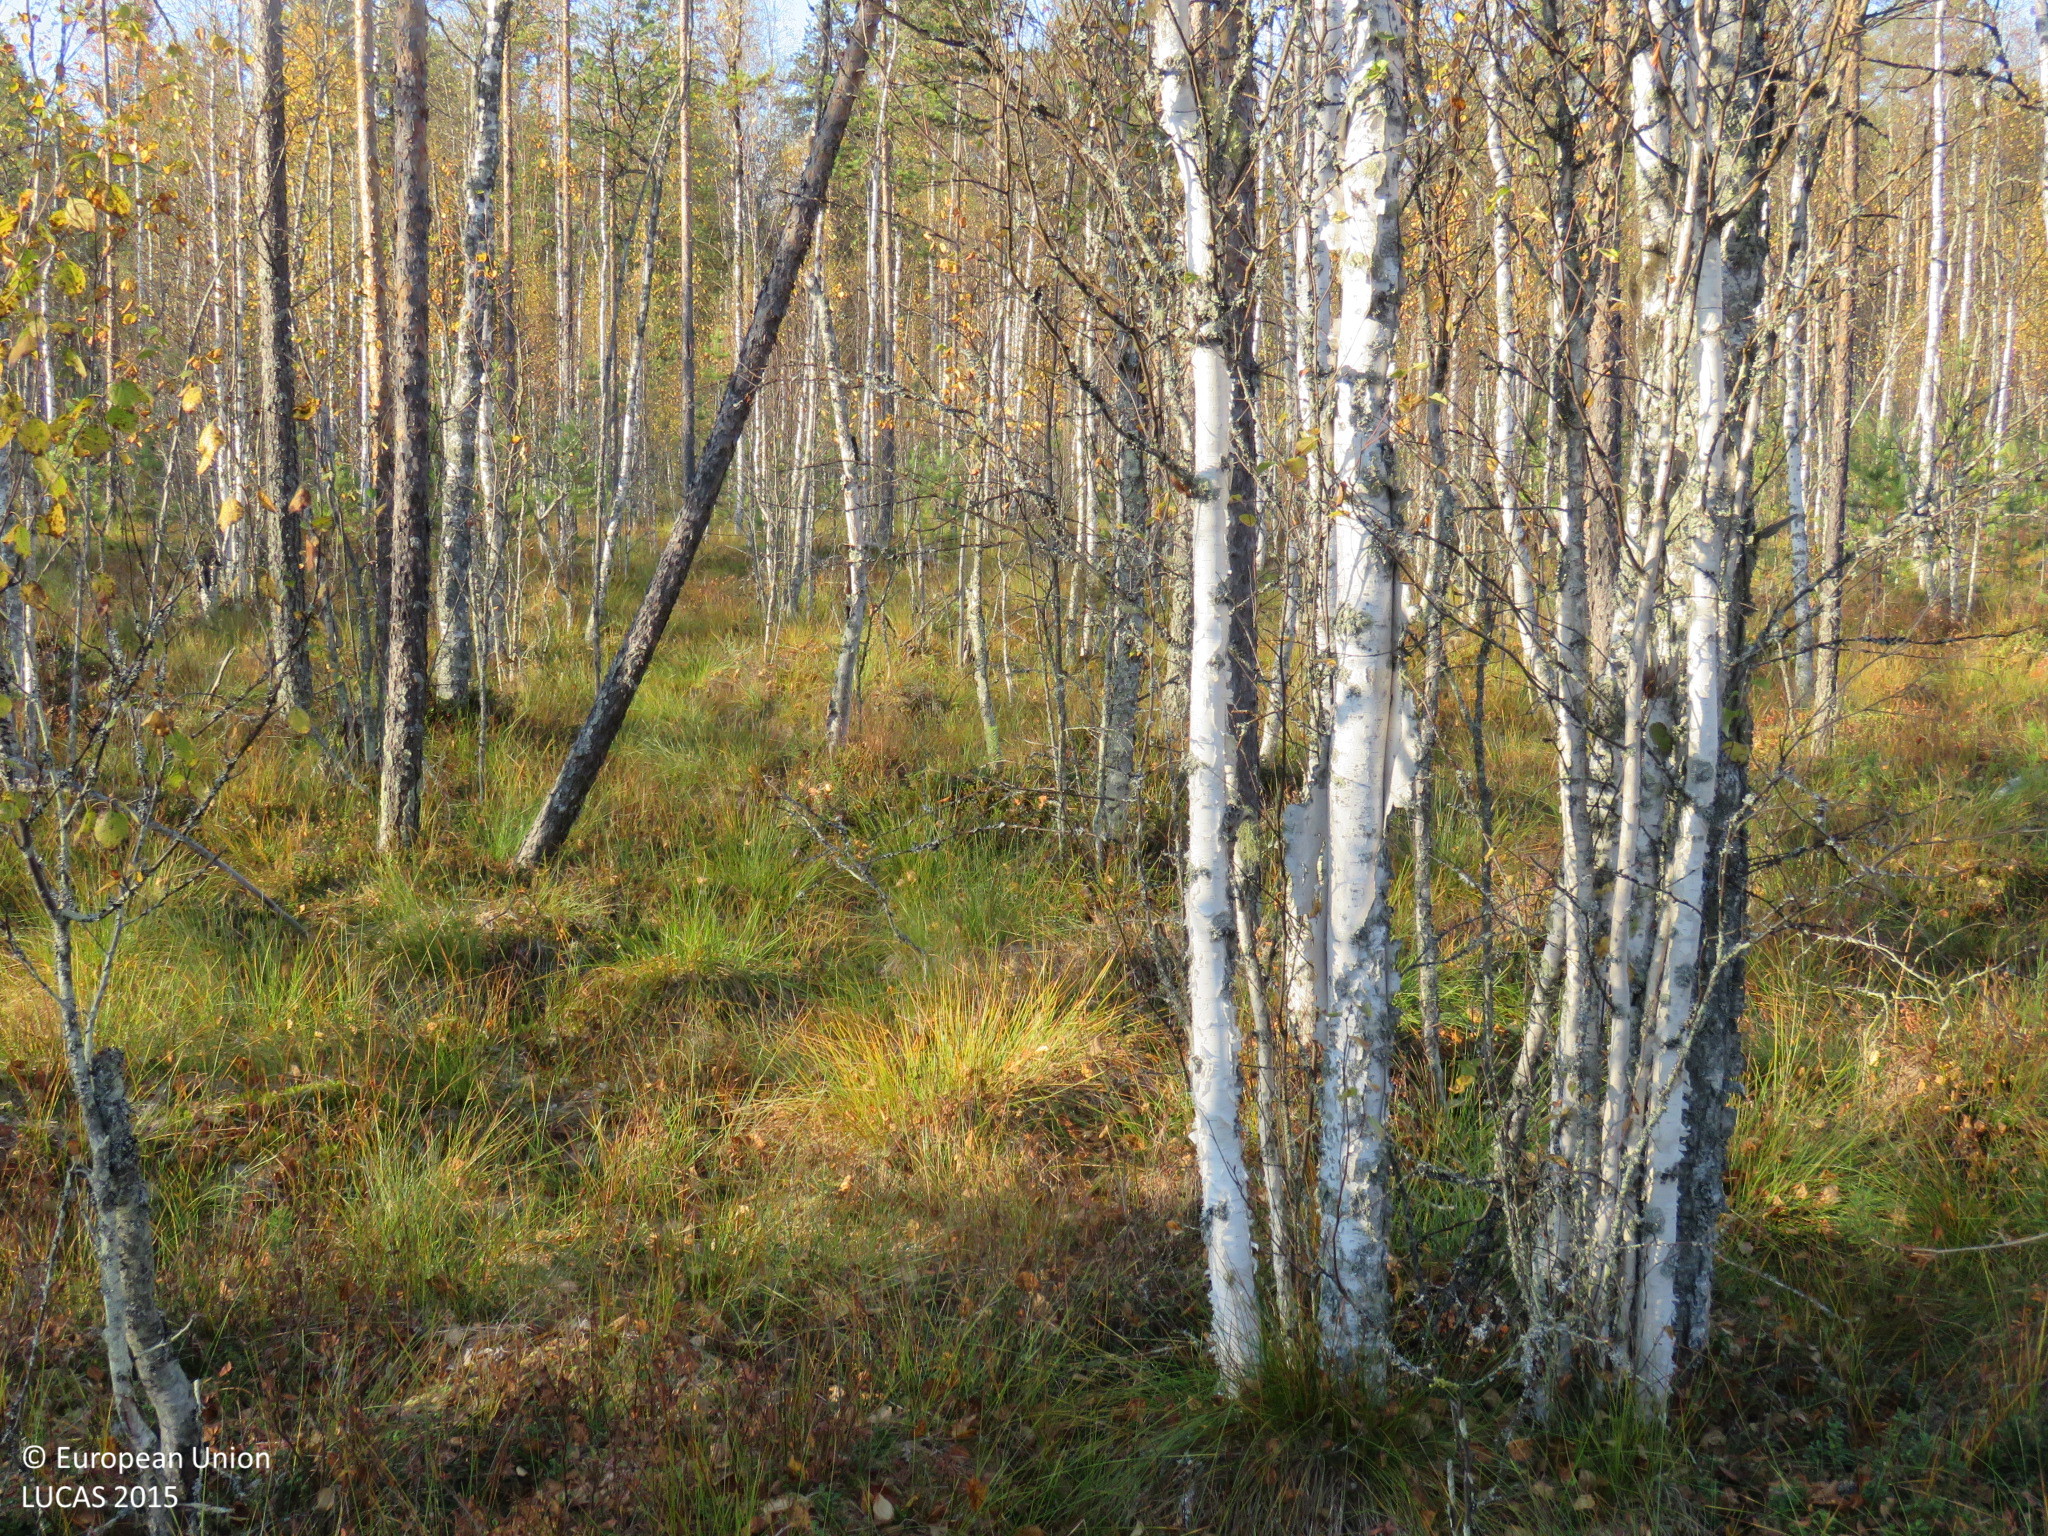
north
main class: Woodland
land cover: Pine dominated mixed woodland
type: mire and swamp forests
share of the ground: > 75 %
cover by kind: broadleaved forest trees 45 %, coniferous forest trees 35 %, shrubs 10 %, herbaceous plants 10 %
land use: Forestry
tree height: > 5 m
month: September
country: FI
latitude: 64.7648
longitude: 26.5302
